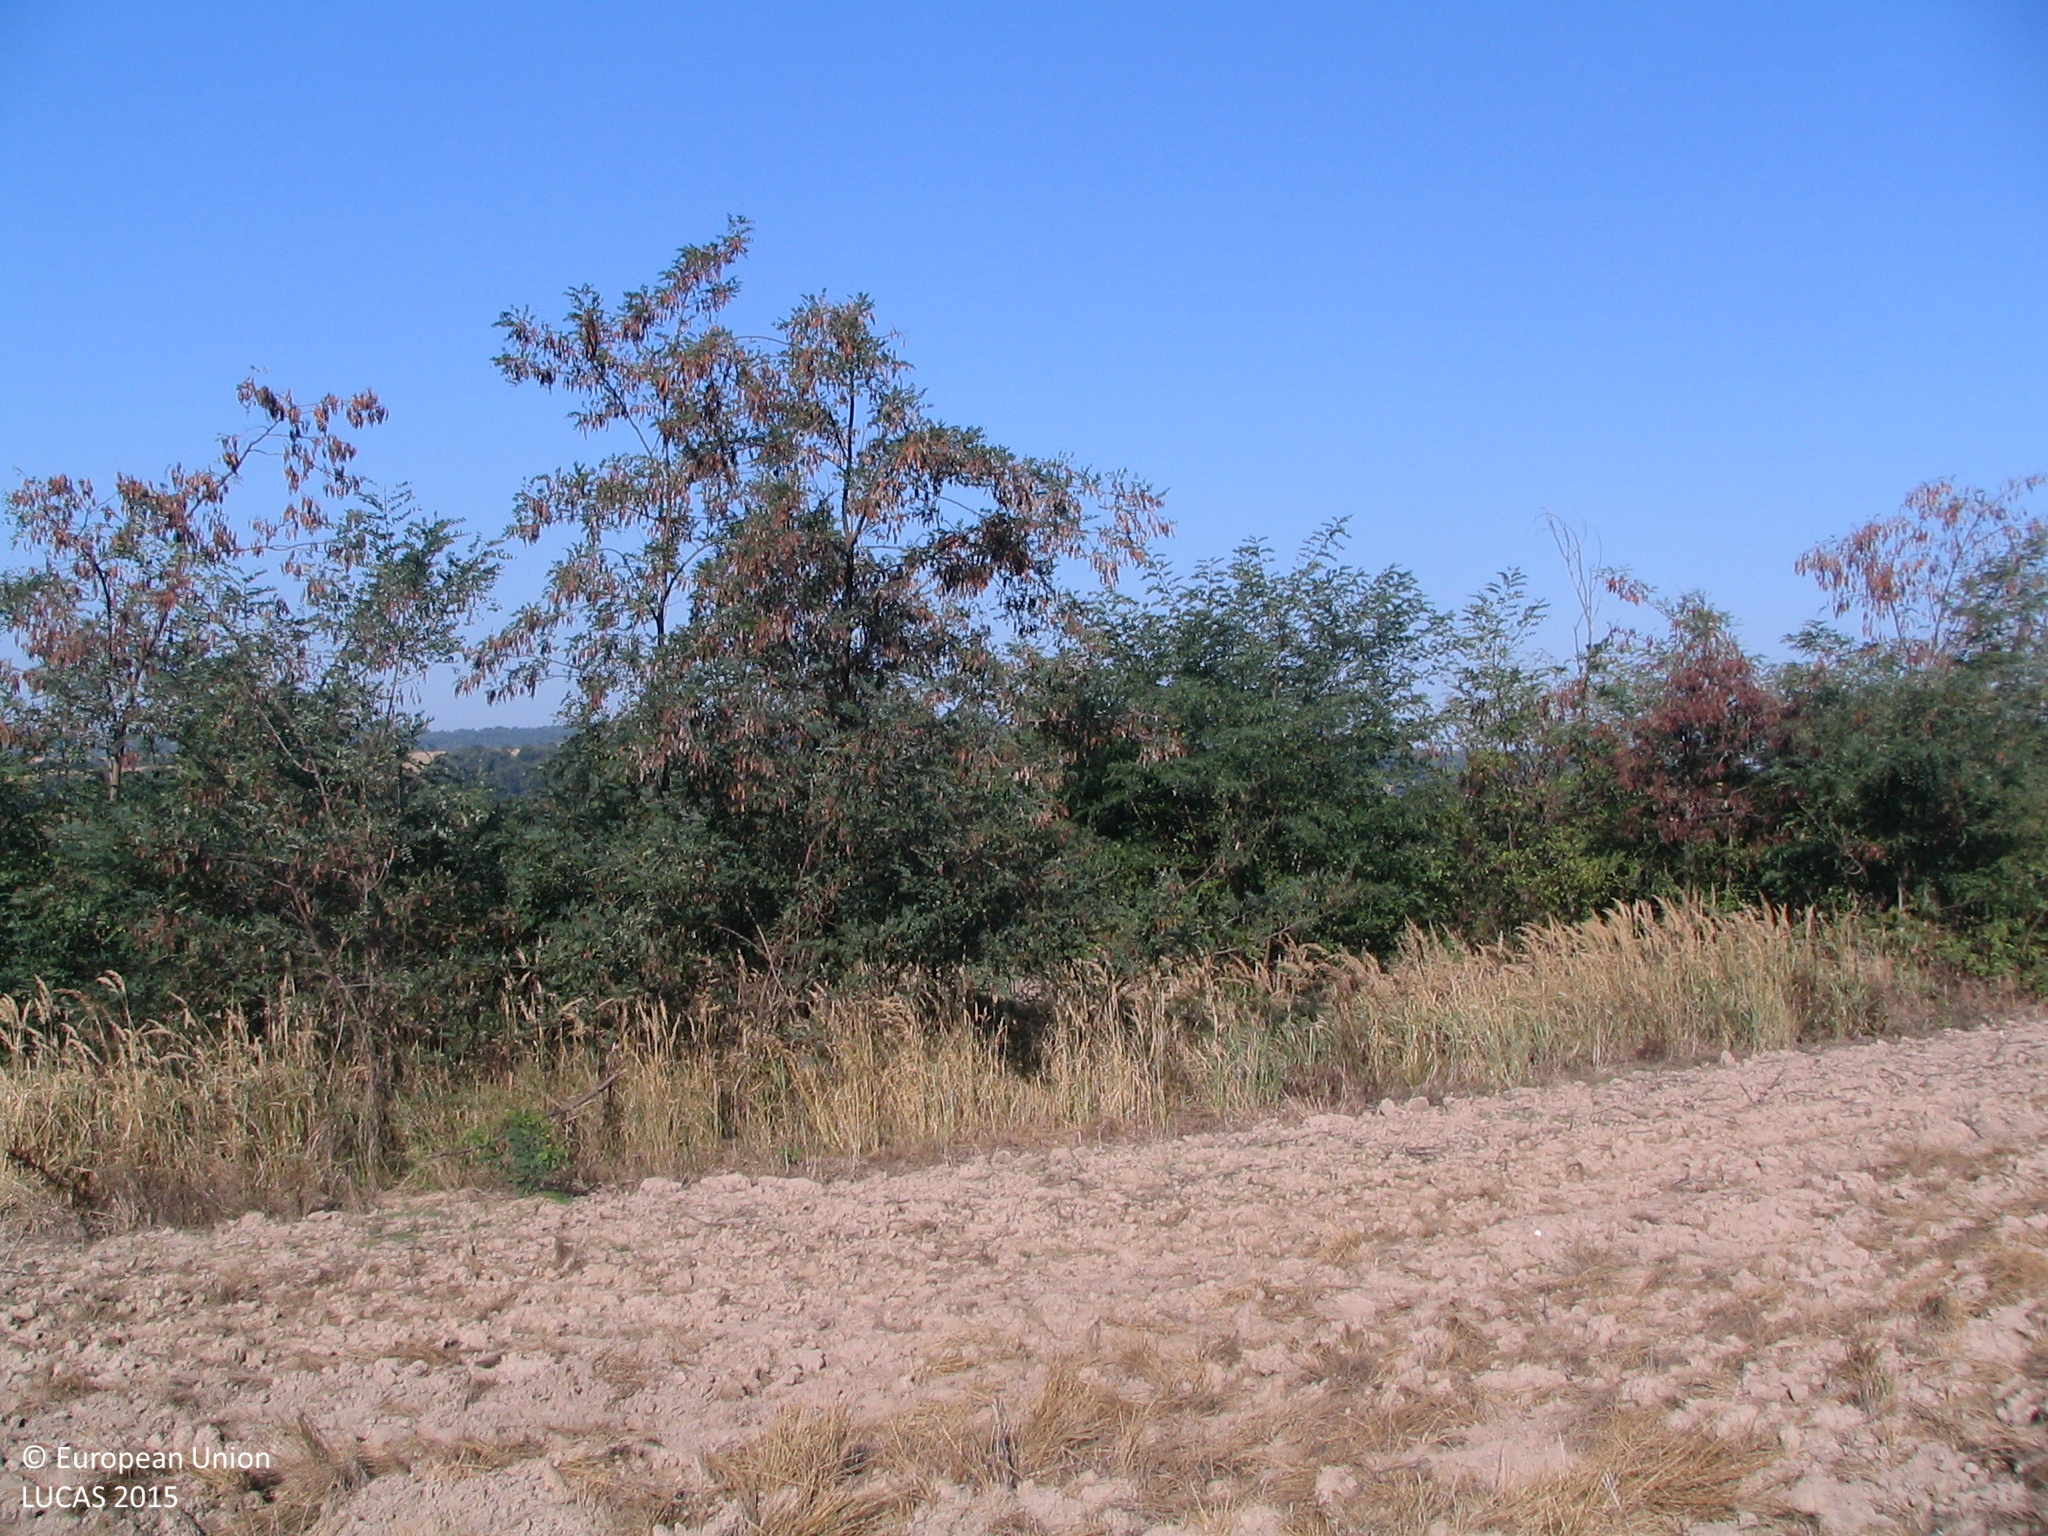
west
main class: Cropland
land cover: Common wheat
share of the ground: < 10 %
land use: Agriculture (excluding fallow land and kitchen gardens)
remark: Harvested field
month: August
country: BG
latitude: 43.0748
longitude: 24.4629
